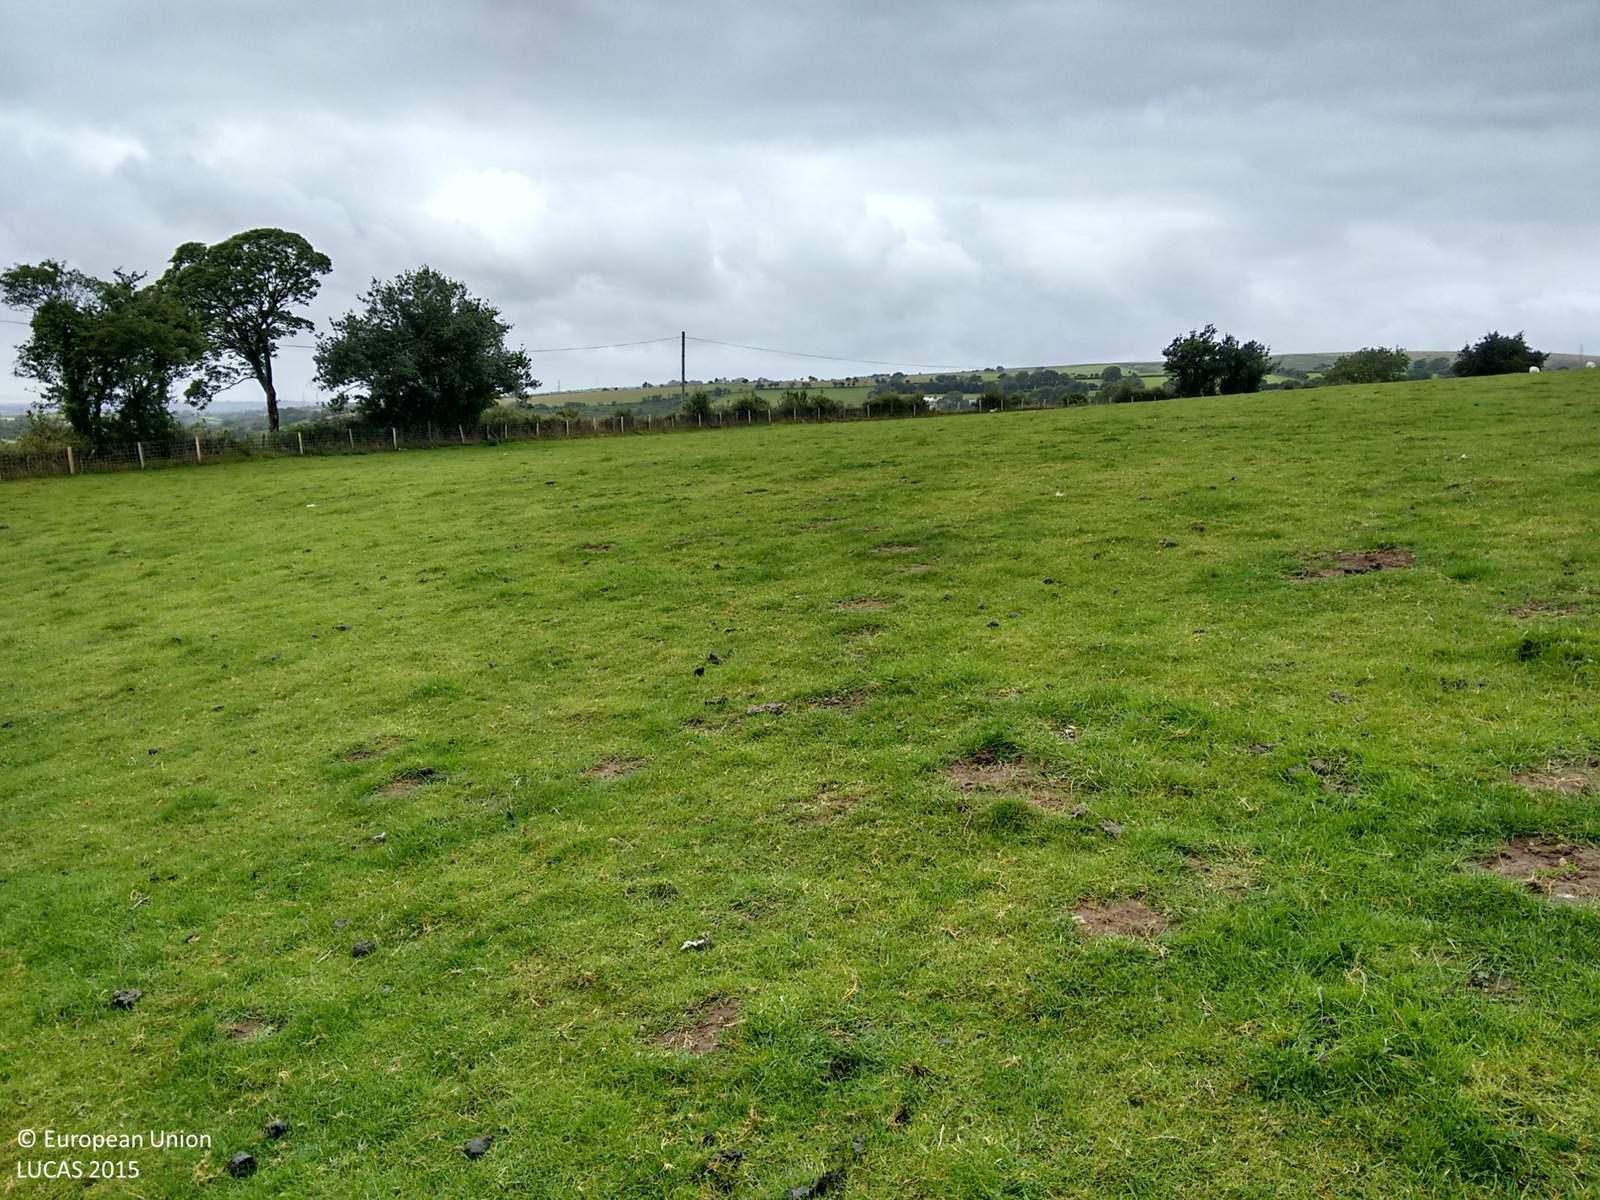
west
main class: Grassland
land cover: Grassland without tree/shrub cover
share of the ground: > 75 %
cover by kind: herbaceous plants 100 %
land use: Agriculture (excluding fallow land and kitchen gardens)
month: July
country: GB
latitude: 51.7133
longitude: -3.9444
